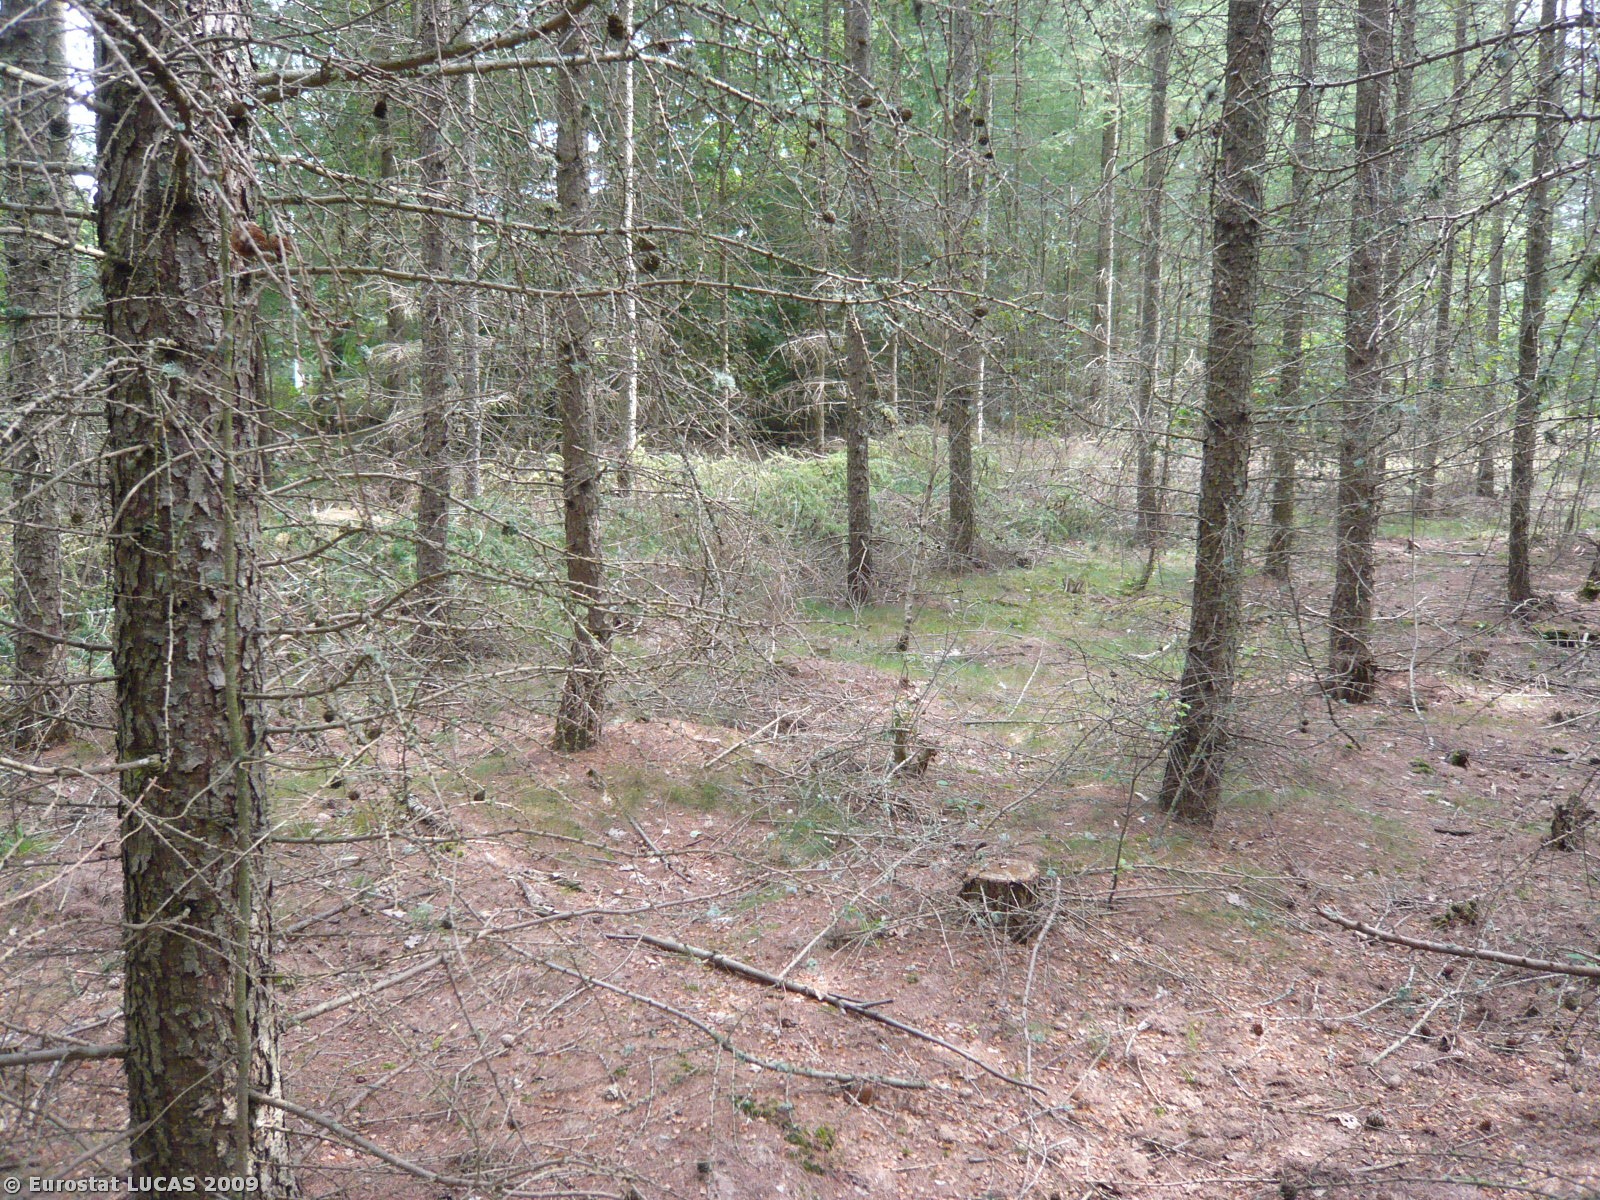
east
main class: Woodland
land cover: Coniferous woodland
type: hemiboreal forest and nemoral coniferous forest and mixed broadleaved-coniferous forest
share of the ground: > 75 %
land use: Forestry
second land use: Amenities, museums, leisure
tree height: > 5 m
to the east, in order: Coniferous woodland; Fences; Artificial constructions in urban areas; Managed hedges; Tracks; Broadleaved woodland; Artificial constructions in urban areas; Broadleaved woodland
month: August
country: DK
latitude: 56.0447
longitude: 12.1009
